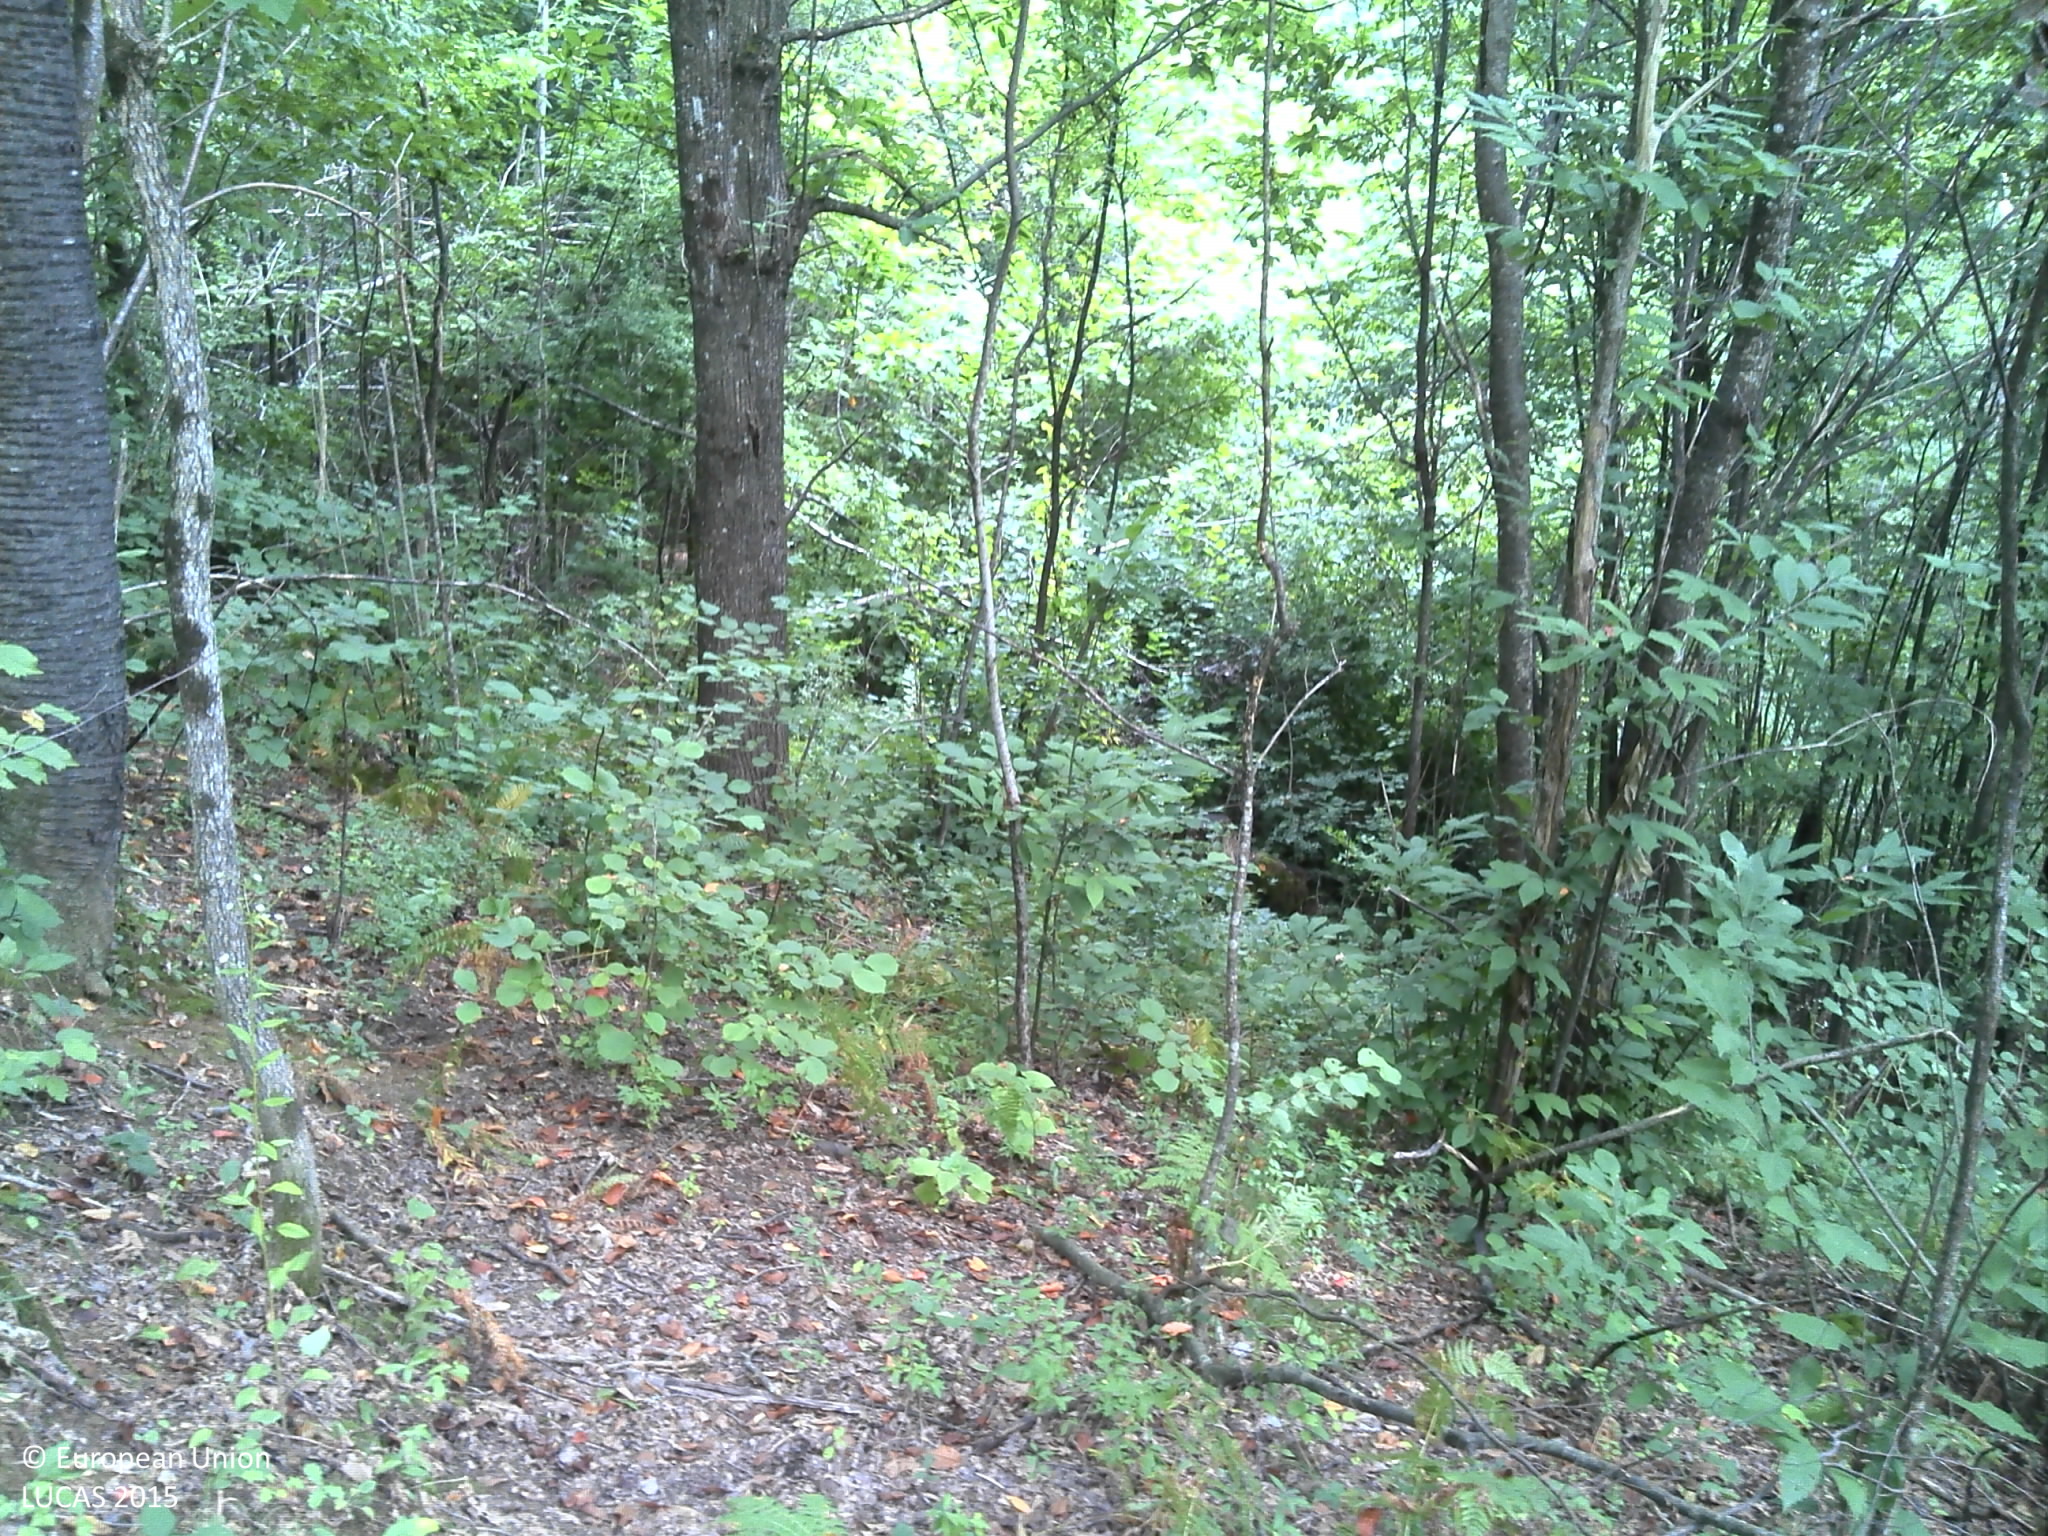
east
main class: Woodland
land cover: Broadleaved woodland
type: beech forest
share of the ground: > 75 %
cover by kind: broadleaved forest trees 100 %
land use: Forestry
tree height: > 5 m
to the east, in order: Broadleaved woodland; Grassland with sparse tree/shrub cover; Shrubland with sparse tree cover; Spontaneously vegetated surfaces; Broadleaved woodland
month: August
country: HR
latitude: 45.2916
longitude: 16.1042
